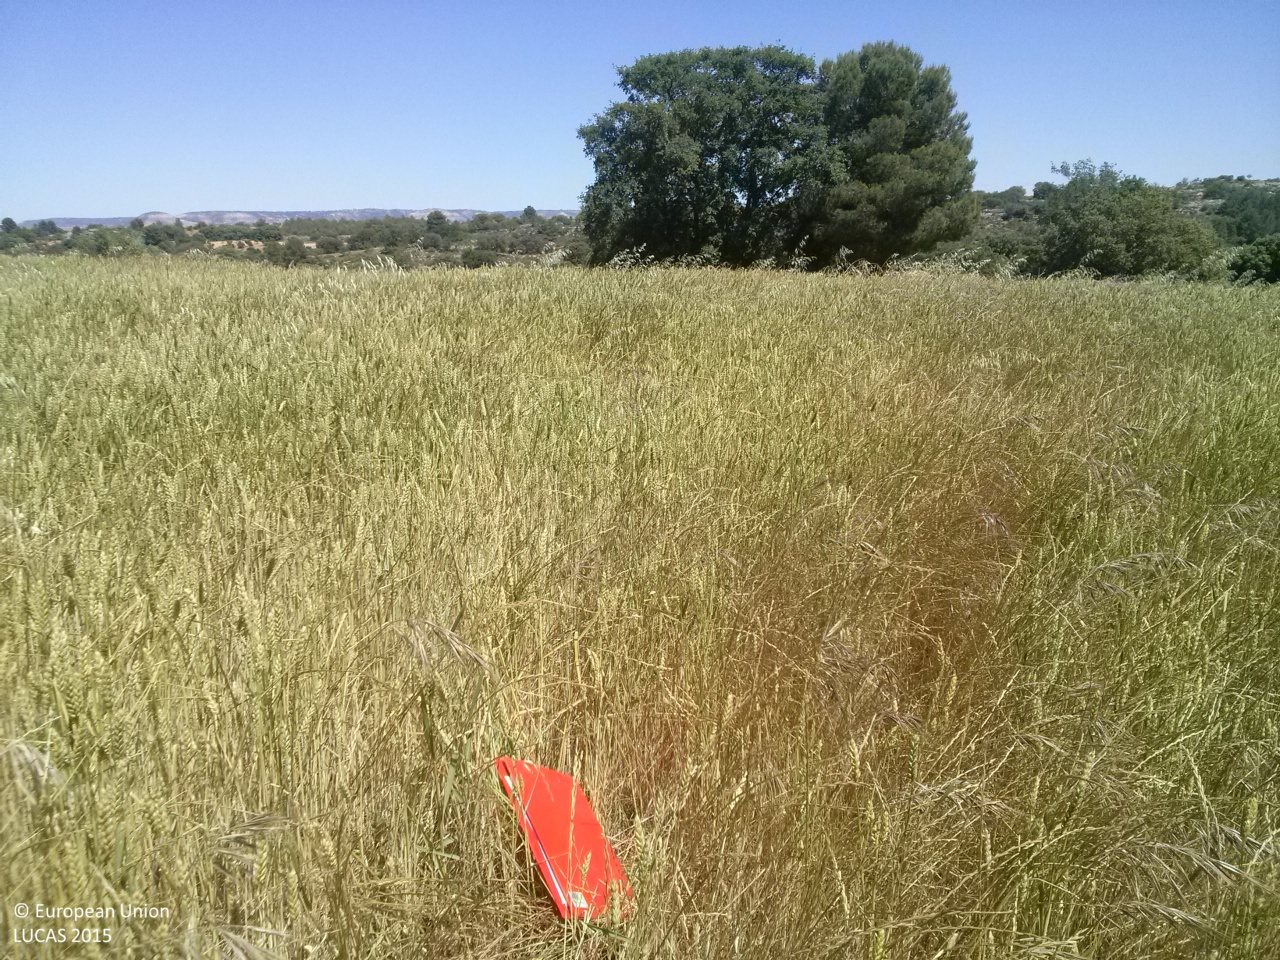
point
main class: Cropland
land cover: Common wheat
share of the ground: > 75 %
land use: Agriculture (excluding fallow land and kitchen gardens)
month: May
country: ES
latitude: 40.3430
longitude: -2.7749
